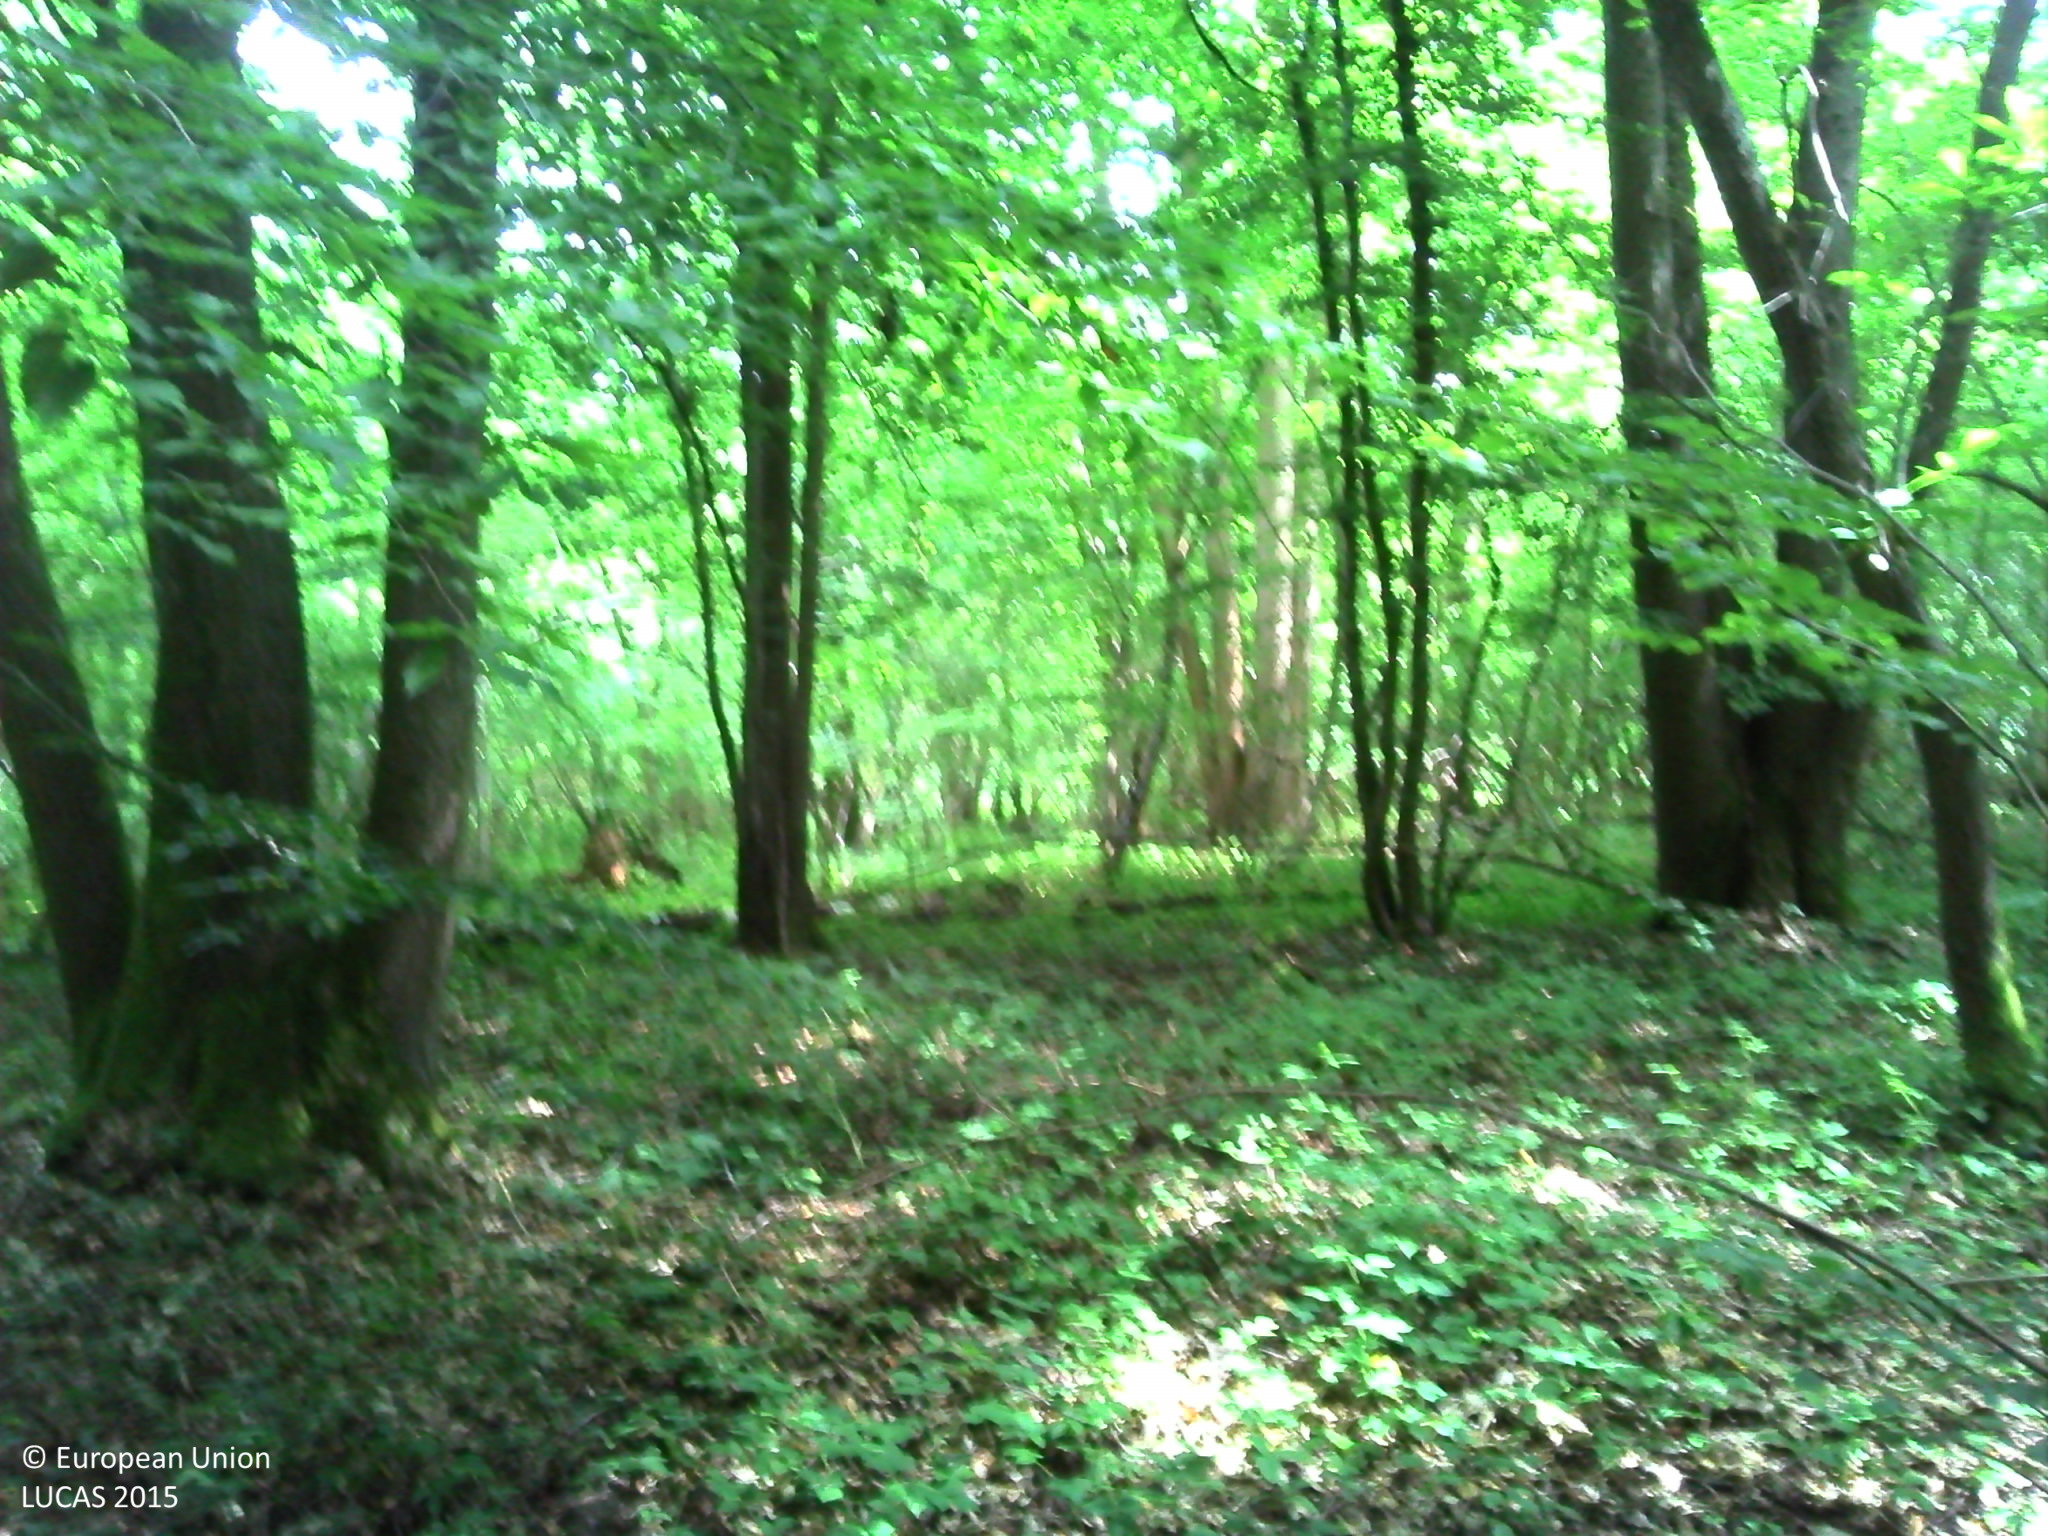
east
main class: Woodland
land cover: Broadleaved woodland
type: mesophytic deciduous forest
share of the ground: > 75 %
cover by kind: broadleaved forest trees 80 %, herbaceous plants 10 %, consolidated bare surface 10 %
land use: Forestry
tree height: > 5 m
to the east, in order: Broadleaved woodland; Tracks; Maize
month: June
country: FR
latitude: 49.2536
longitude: 1.0619
